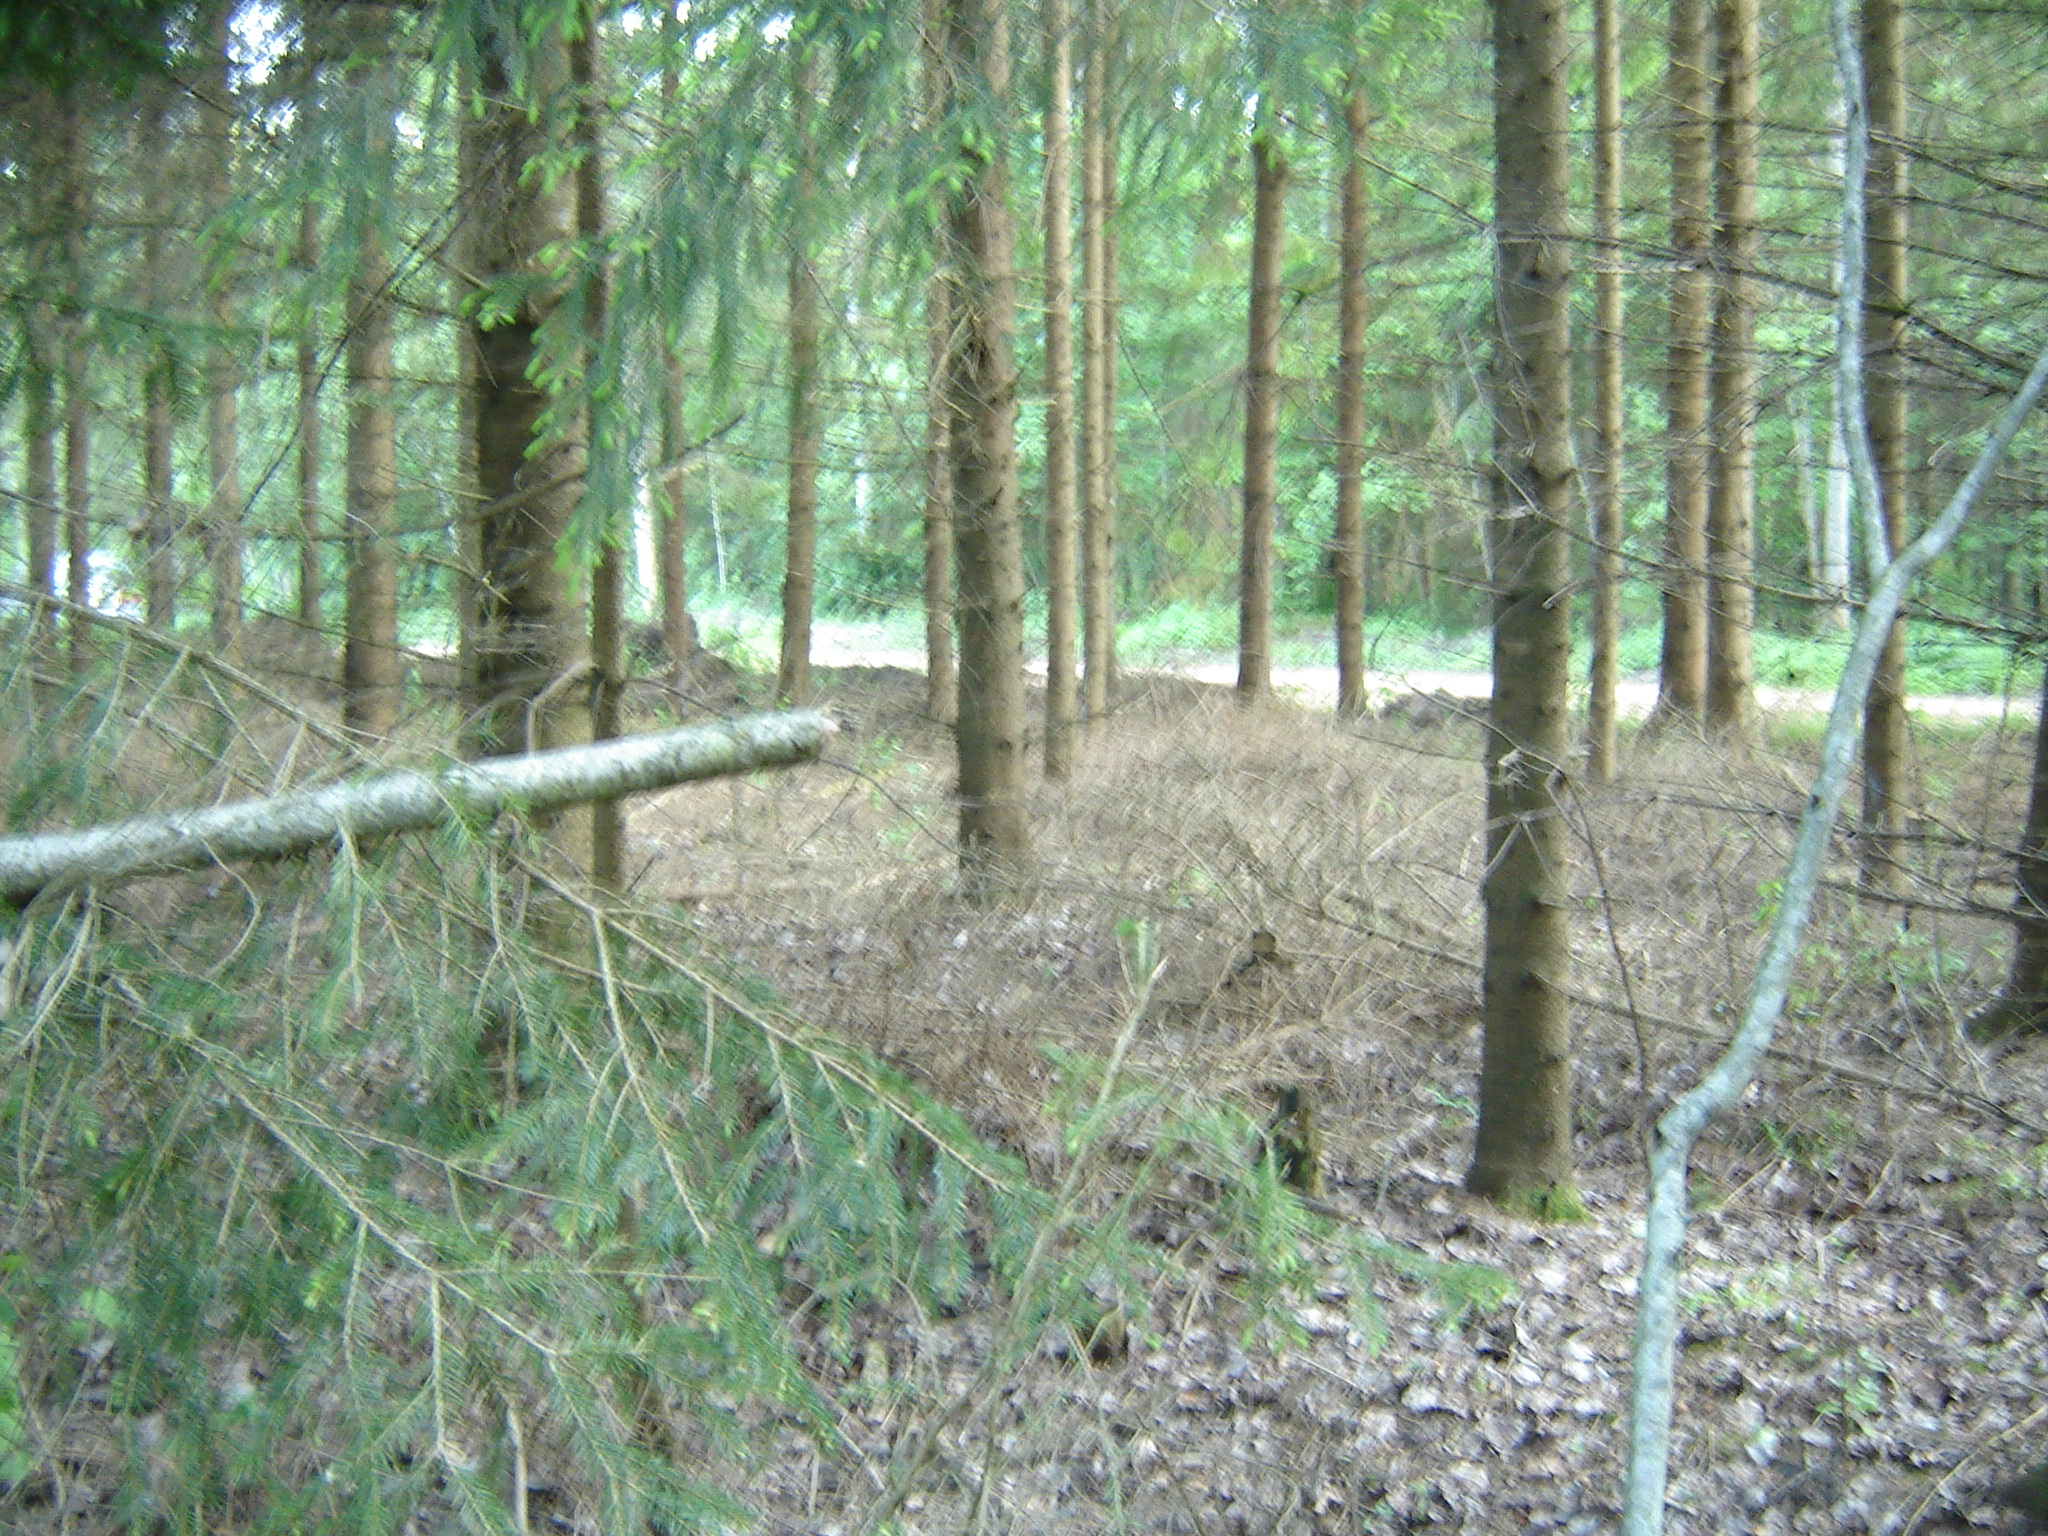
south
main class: Woodland
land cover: Spruce dominated mixed woodland
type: hemiboreal forest and nemoral coniferous forest and mixed broadleaved-coniferous forest
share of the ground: > 75 %
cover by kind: coniferous forest trees 50 %, broadleaved forest trees 50 %
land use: Forestry
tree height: > 5 m
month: June
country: LT
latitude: 55.8406
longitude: 25.3701
